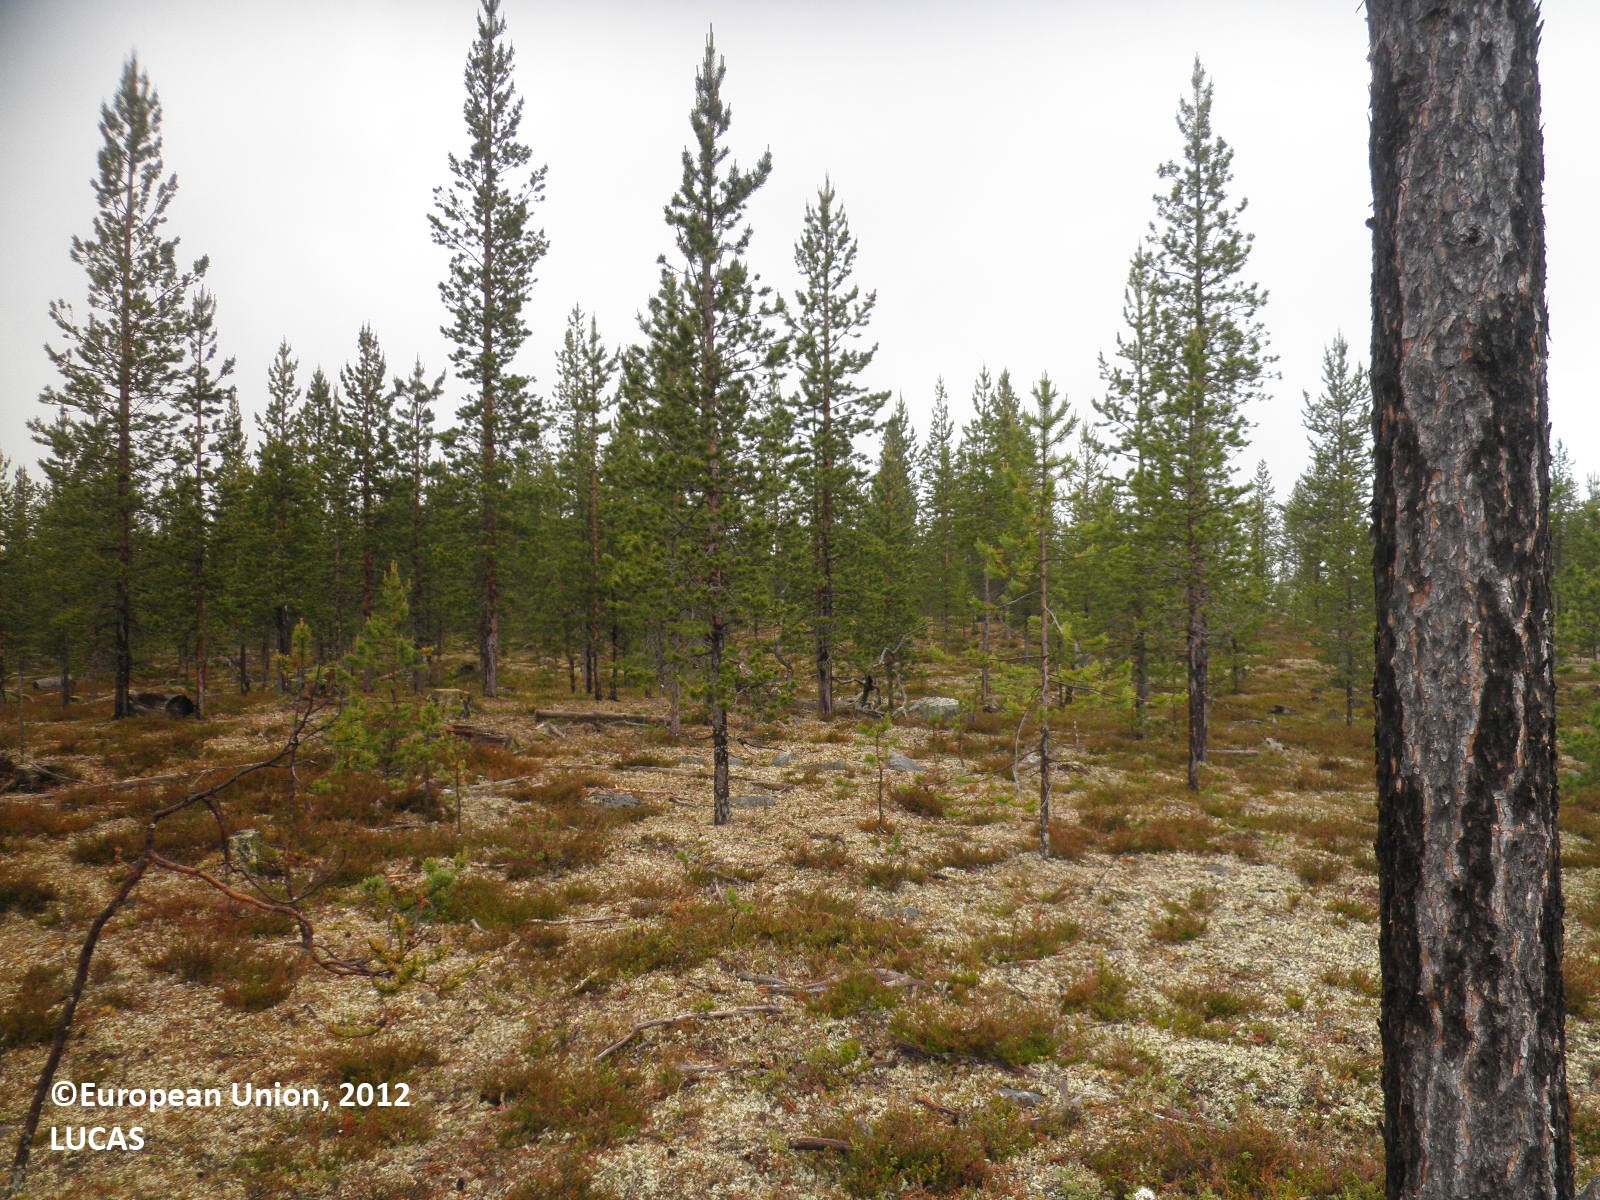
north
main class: Woodland
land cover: Pine dominated coniferous woodland
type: boreal forest
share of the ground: 25 - 50 %
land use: Forestry
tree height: > 5 m
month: June
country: FI
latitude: 68.4796
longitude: 27.7986
